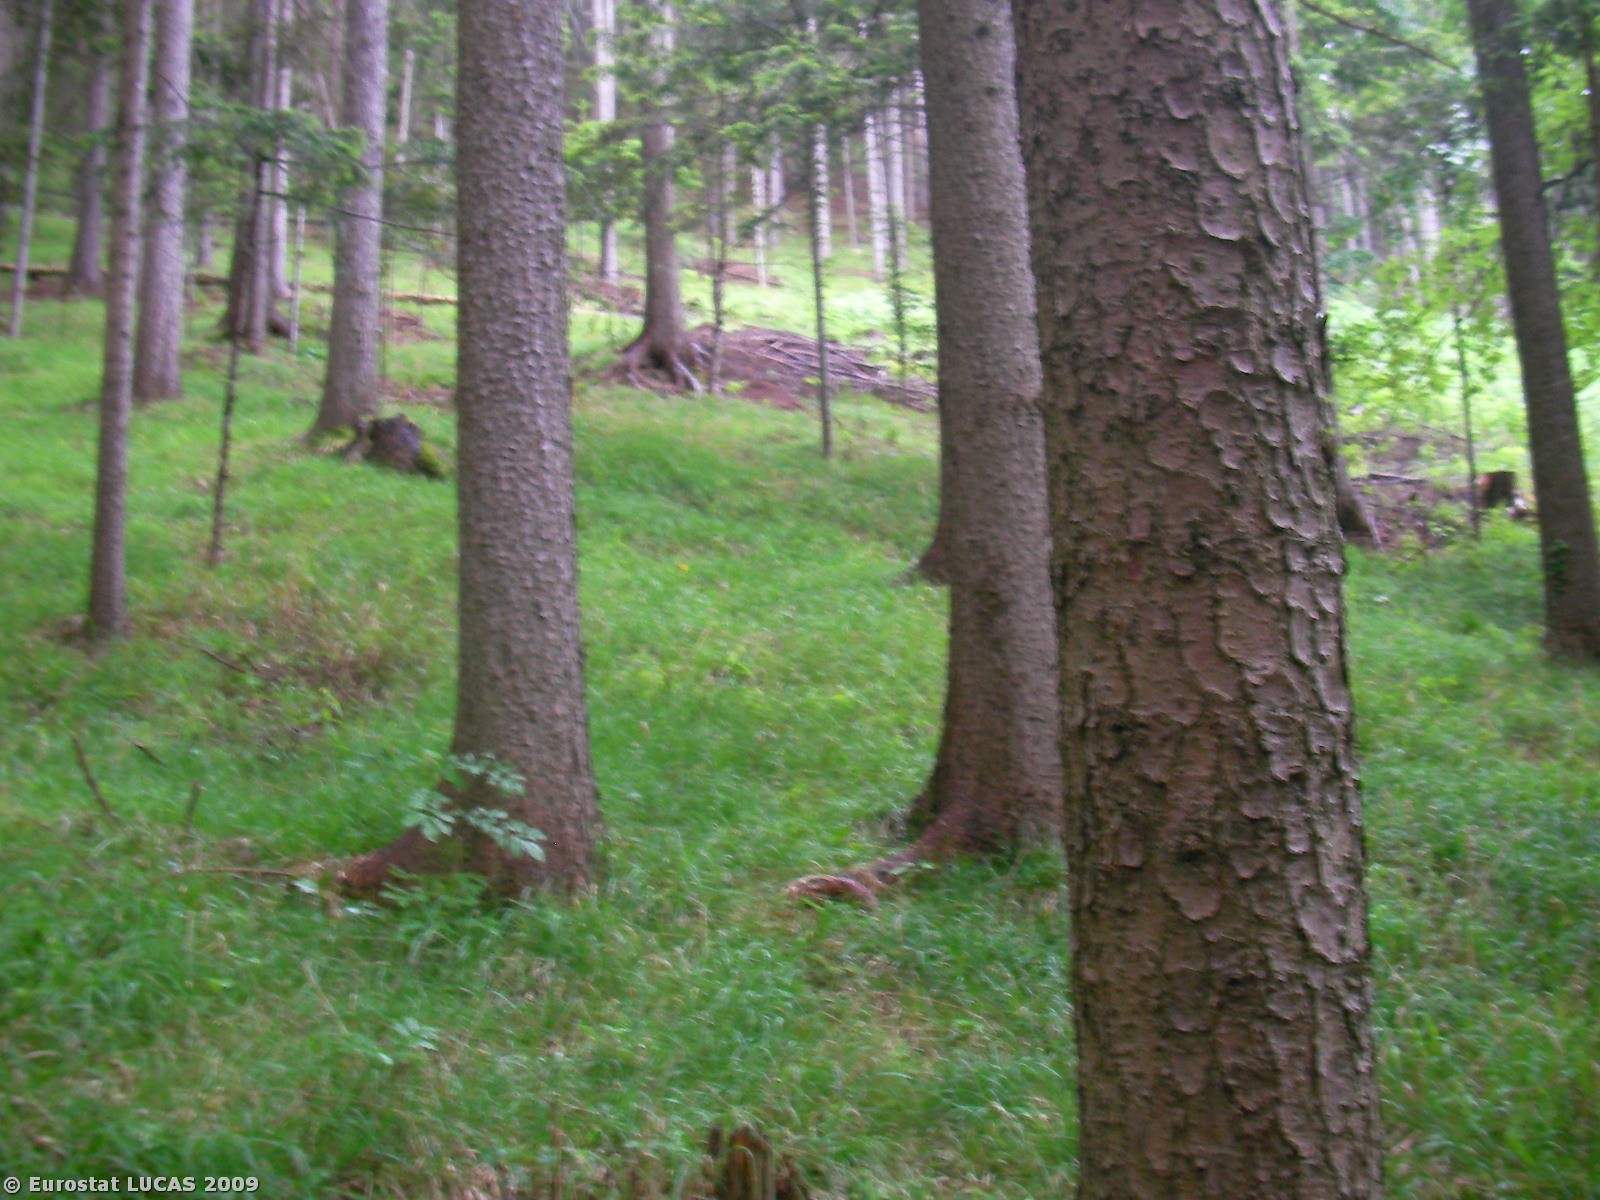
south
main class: Woodland
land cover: Coniferous woodland
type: alpine coniferous forest
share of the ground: > 75 %
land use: Forestry
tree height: > 5 m
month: May
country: AT
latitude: 47.2712
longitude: 15.5654
